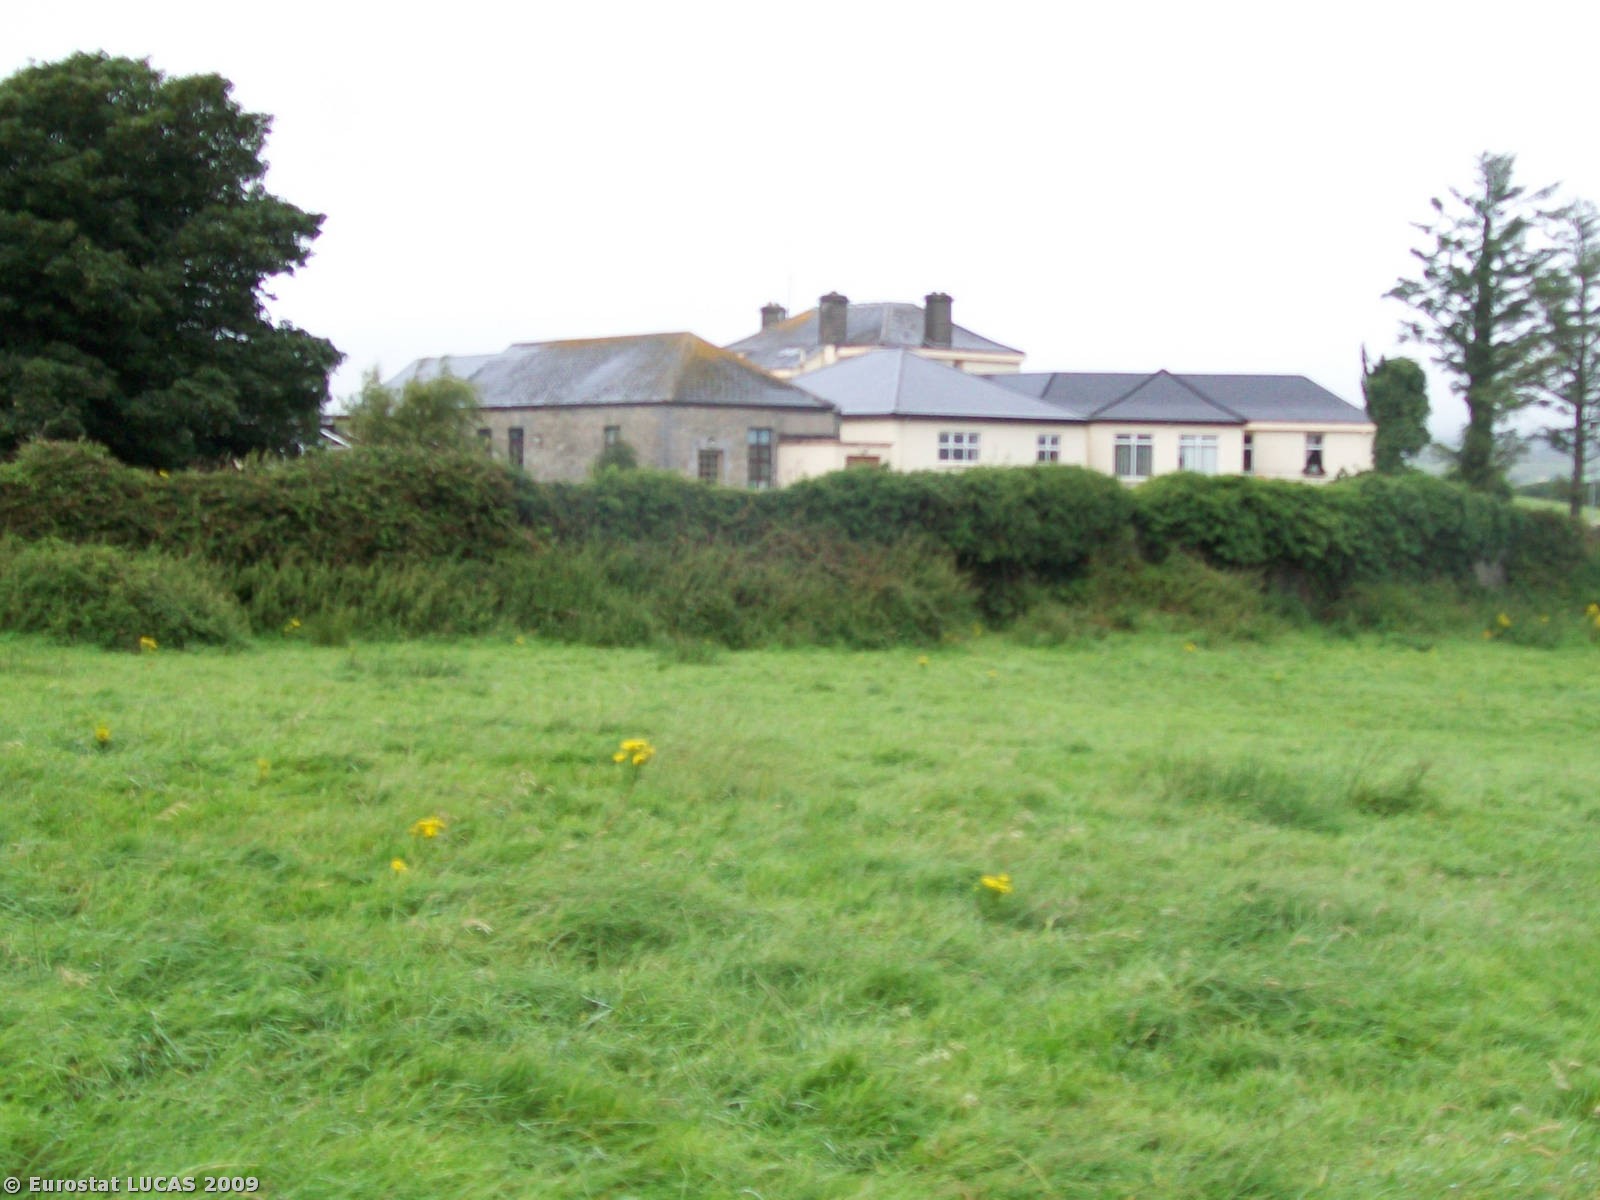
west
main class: Grassland
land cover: Grassland without tree/shrub cover
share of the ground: > 75 %
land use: Agriculture (excluding fallow land and kitchen gardens)
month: August
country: IE
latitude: 52.9357
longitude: -9.3145
